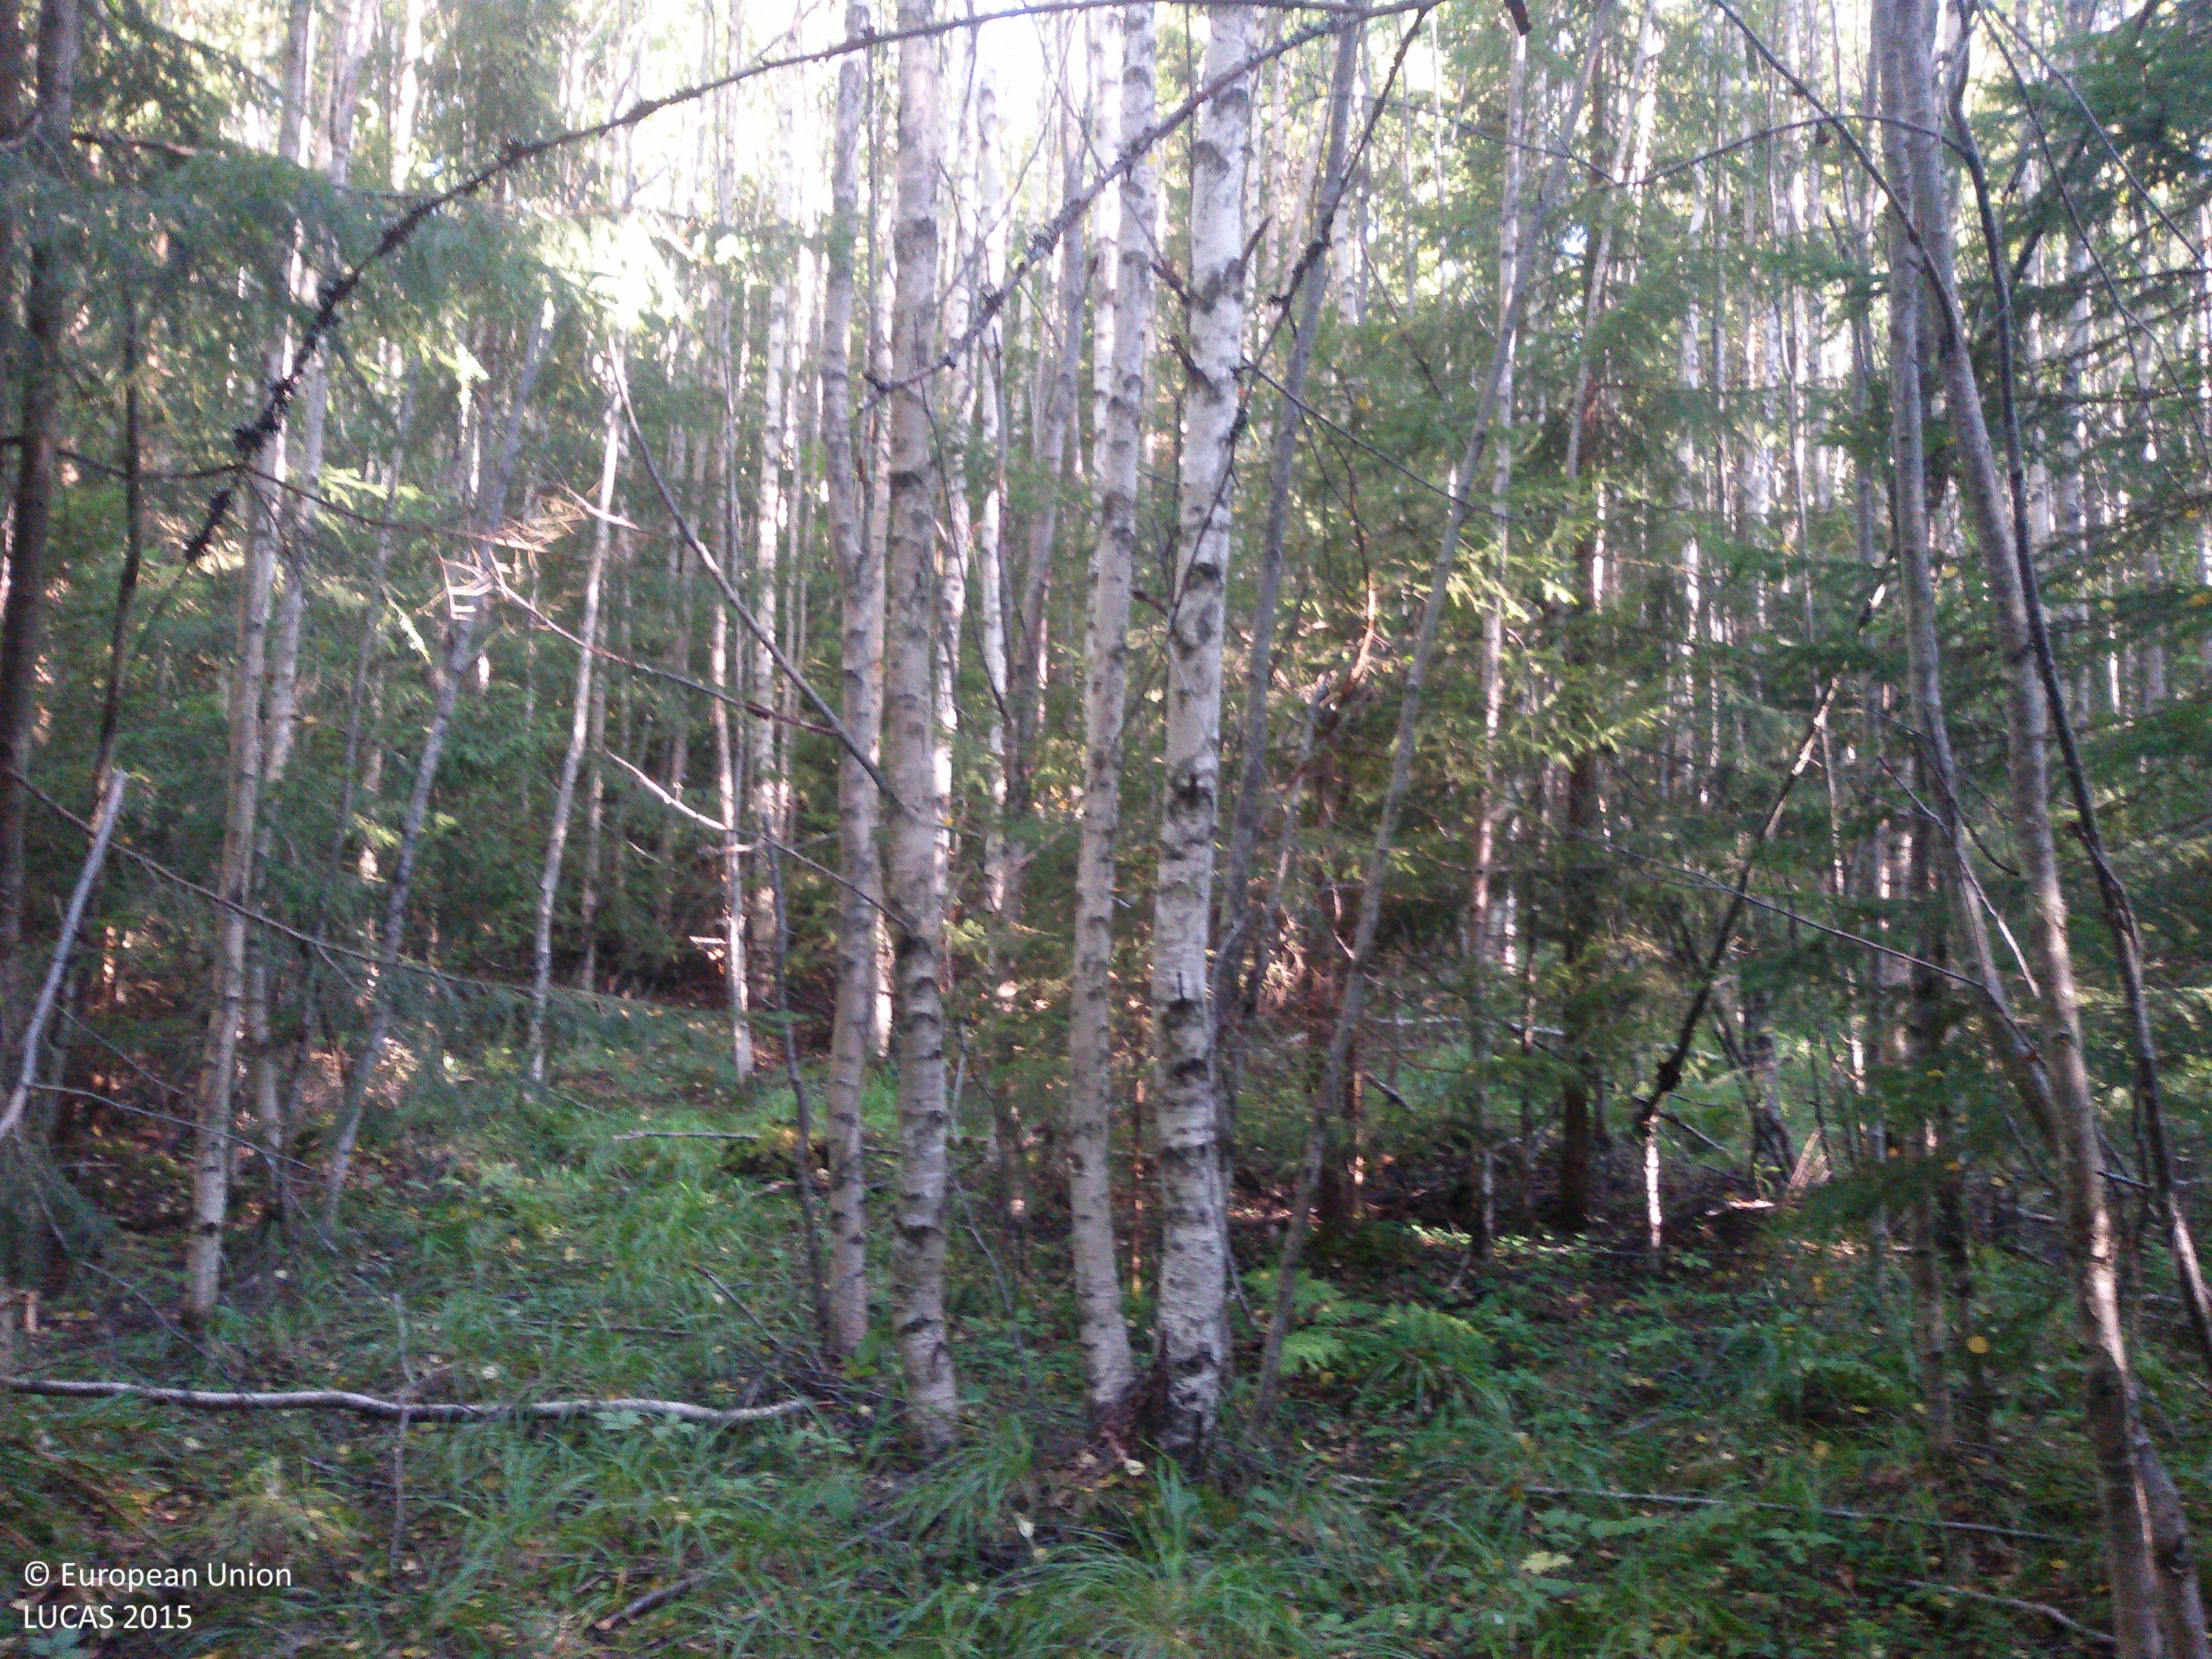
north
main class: Woodland
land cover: Spruce dominated mixed woodland
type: boreal forest
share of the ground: > 75 %
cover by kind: coniferous forest trees 60 %, broadleaved forest trees 20 %, herbaceous plants 10 %, lichens and mosses 10 %
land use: Forestry
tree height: > 5 m
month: September
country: SE
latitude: 60.8570
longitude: 15.3064
